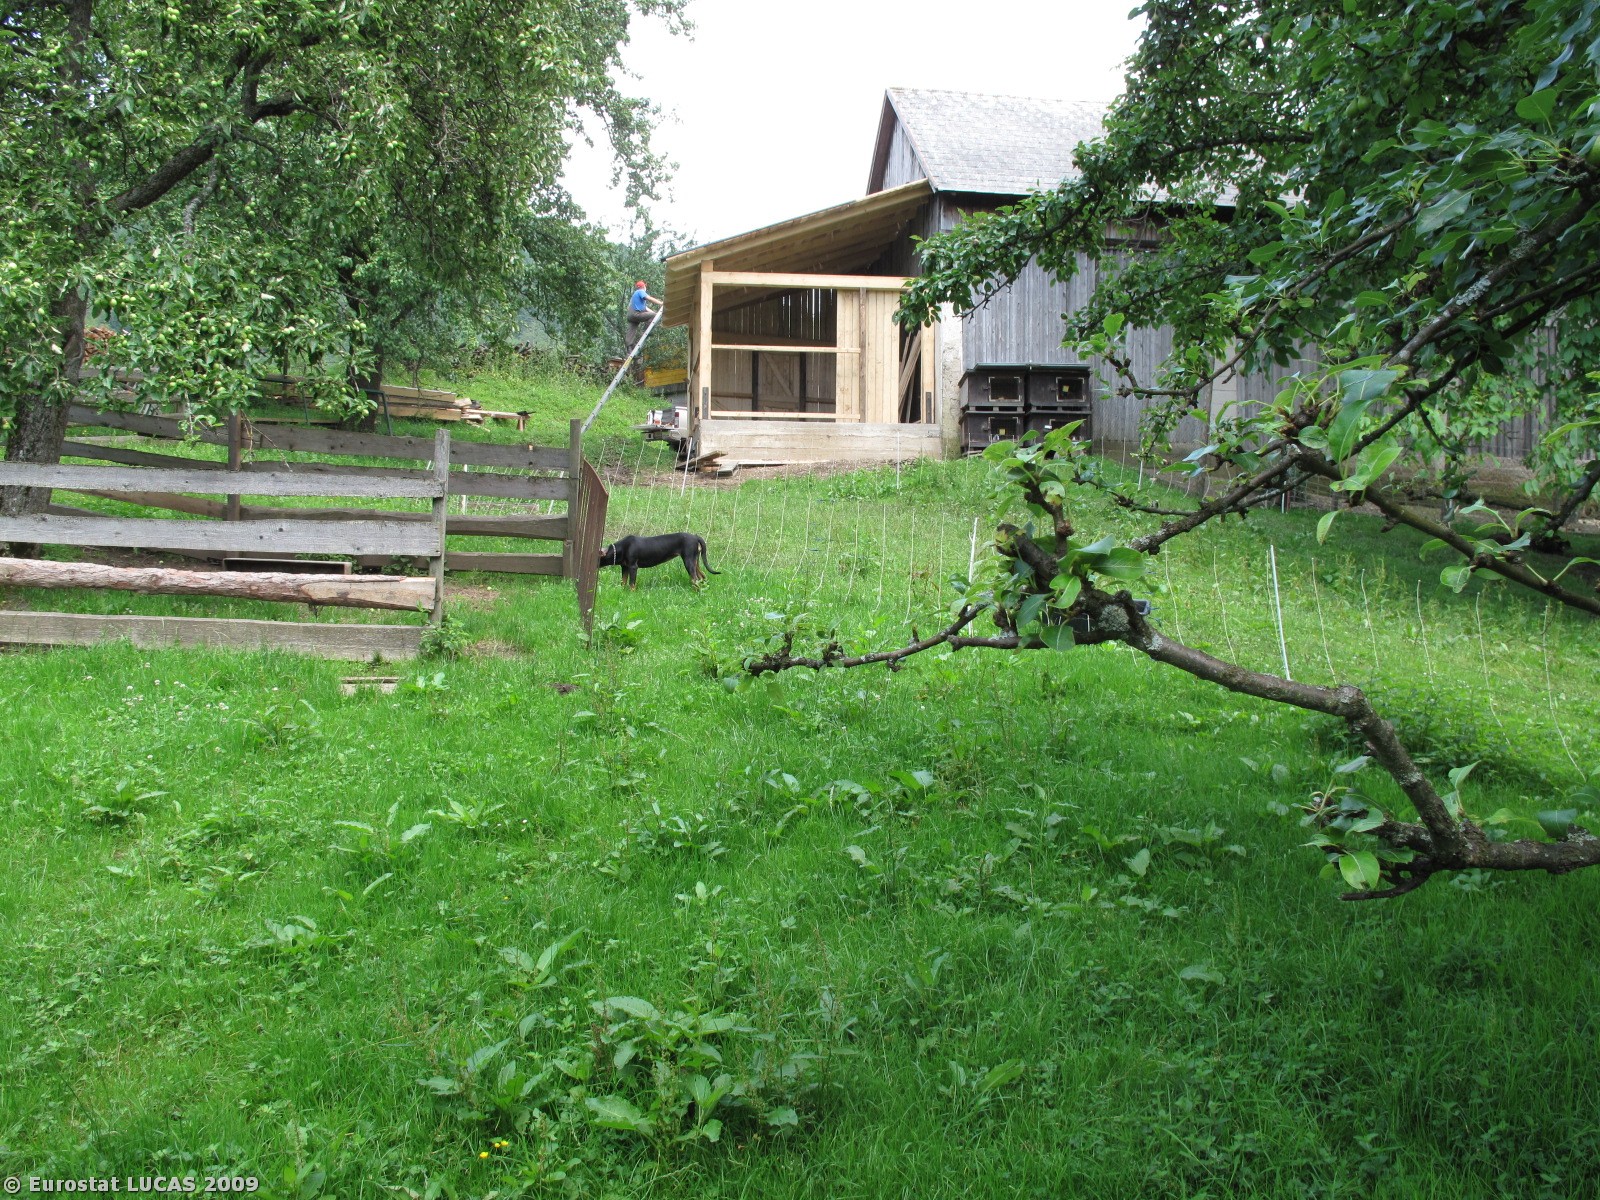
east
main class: Cropland
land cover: Pear fruit
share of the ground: 25 - 50 %
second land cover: Grassland with sparse tree/shrub cover
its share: > 75 %
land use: Agriculture (excluding fallow land and kitchen gardens)
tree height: > 5 m
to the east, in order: Pear fruit; Artificial constructions in urban areas; Grassland without tree/shrub cover; Tracks; Single bushes/trees; Fences; Grassland without tree/shrub cover; Fences; Broadleaved woodland; Grassland without tree/shrub cover; Tracks; Grassland without tree/shrub cover; Single bushes/trees; Grassland without tree/shrub cover; Tracks; Shrubland with sparse tree cover; Mixed woodland; Fences; Mixed woodland
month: July
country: AT
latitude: 48.0067
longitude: 15.6456
